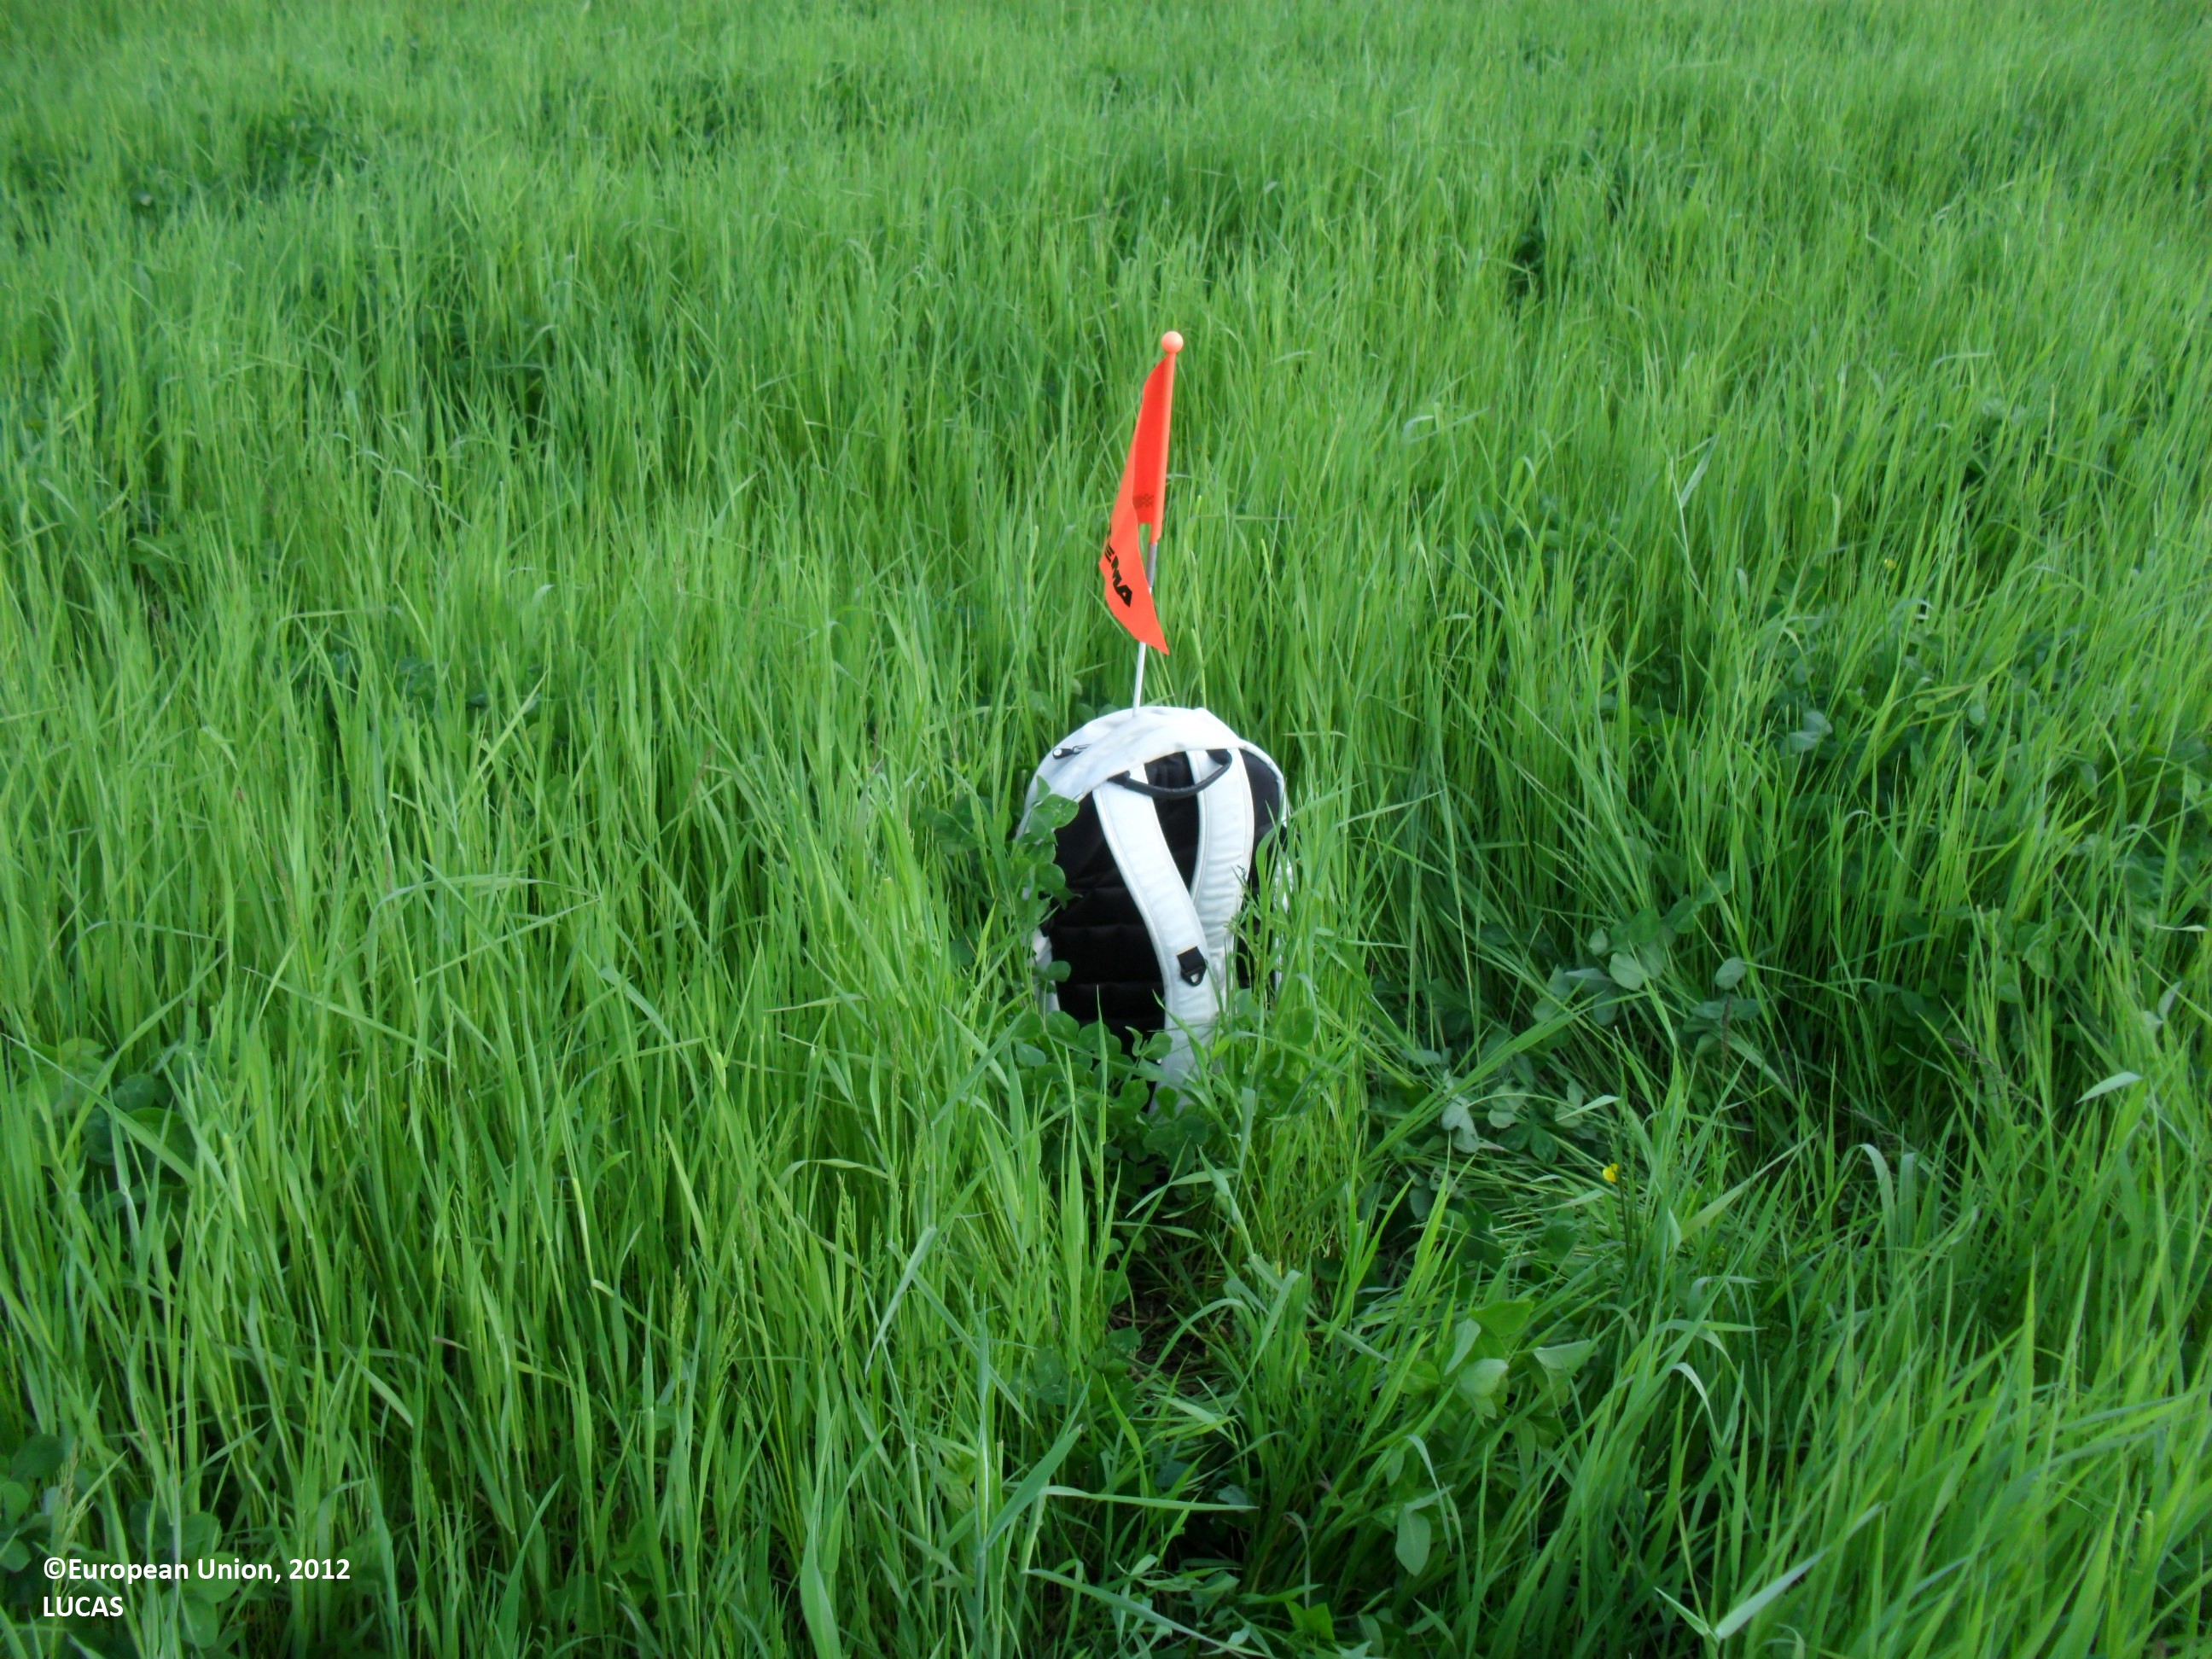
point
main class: Cropland
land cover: Temporary grasslands
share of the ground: > 75 %
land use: Agriculture (excluding fallow land and kitchen gardens)
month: June
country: FI
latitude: 62.9685
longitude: 23.1371
